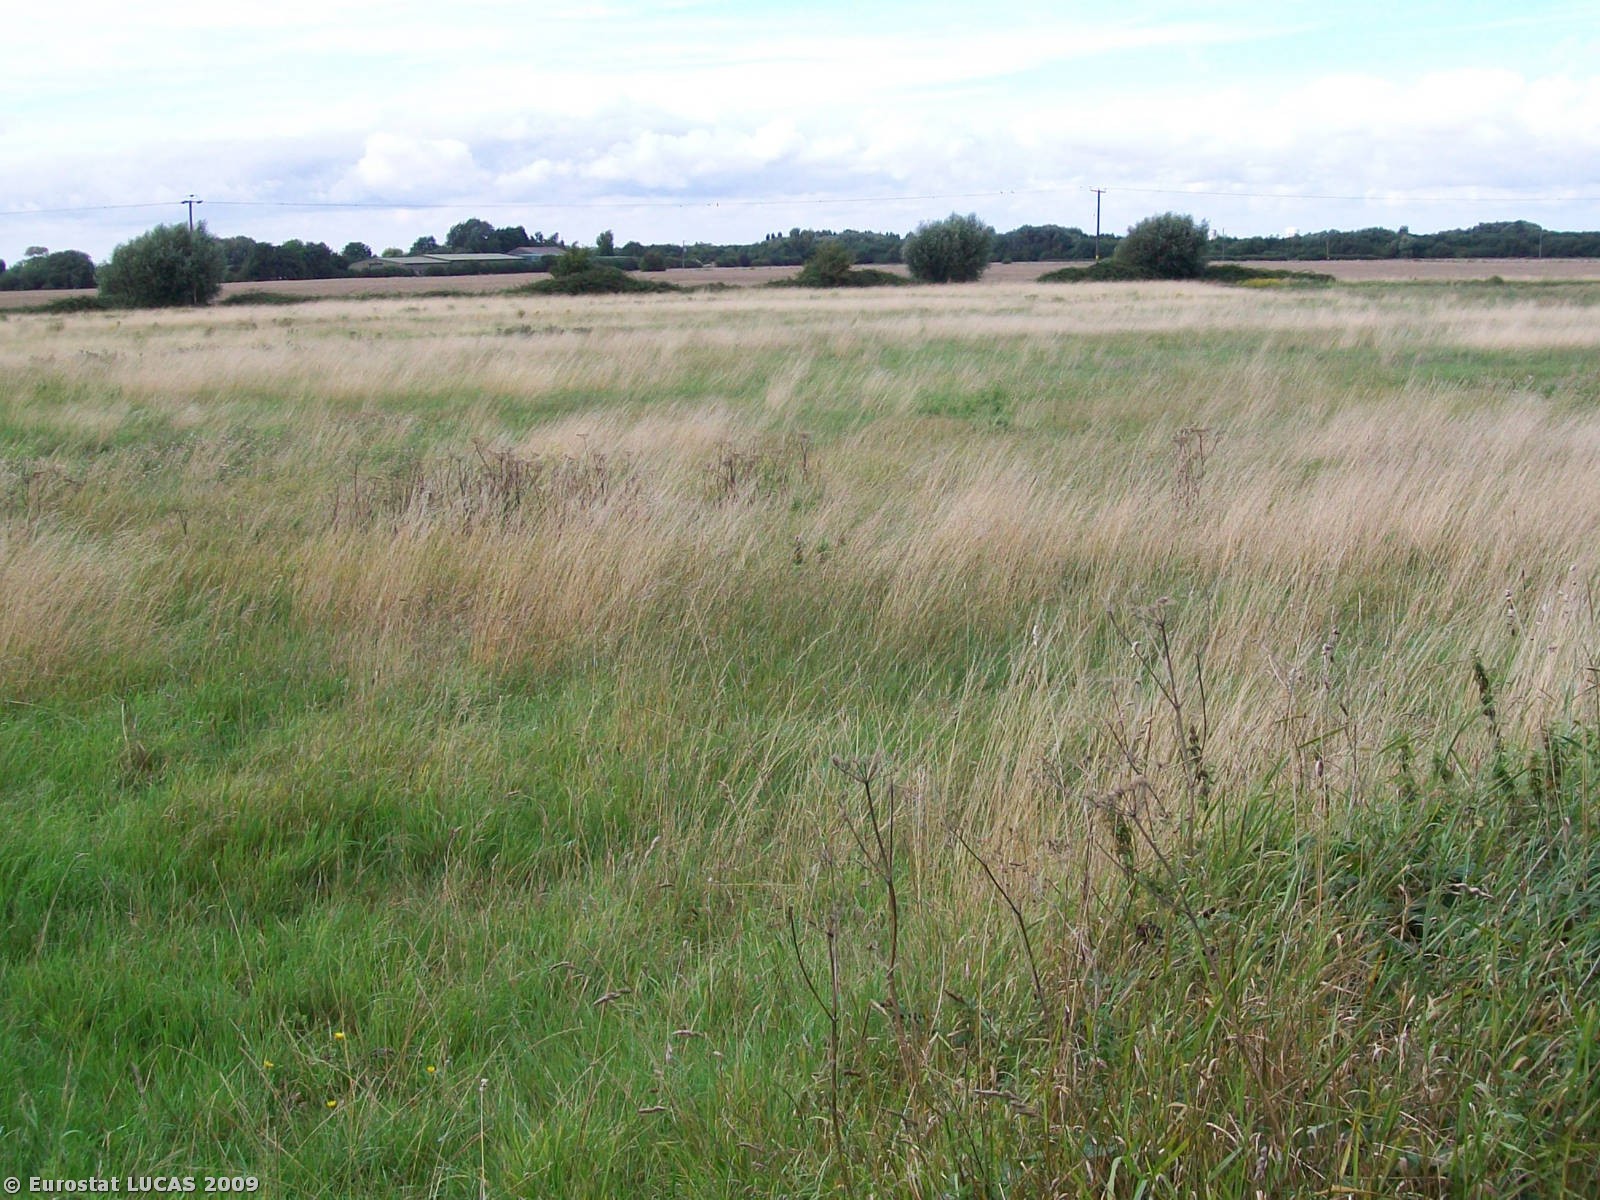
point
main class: Grassland
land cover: Grassland without tree/shrub cover
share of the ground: > 75 %
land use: Agriculture (excluding fallow land and kitchen gardens)
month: August
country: GB
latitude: 52.3171
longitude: 0.0066
